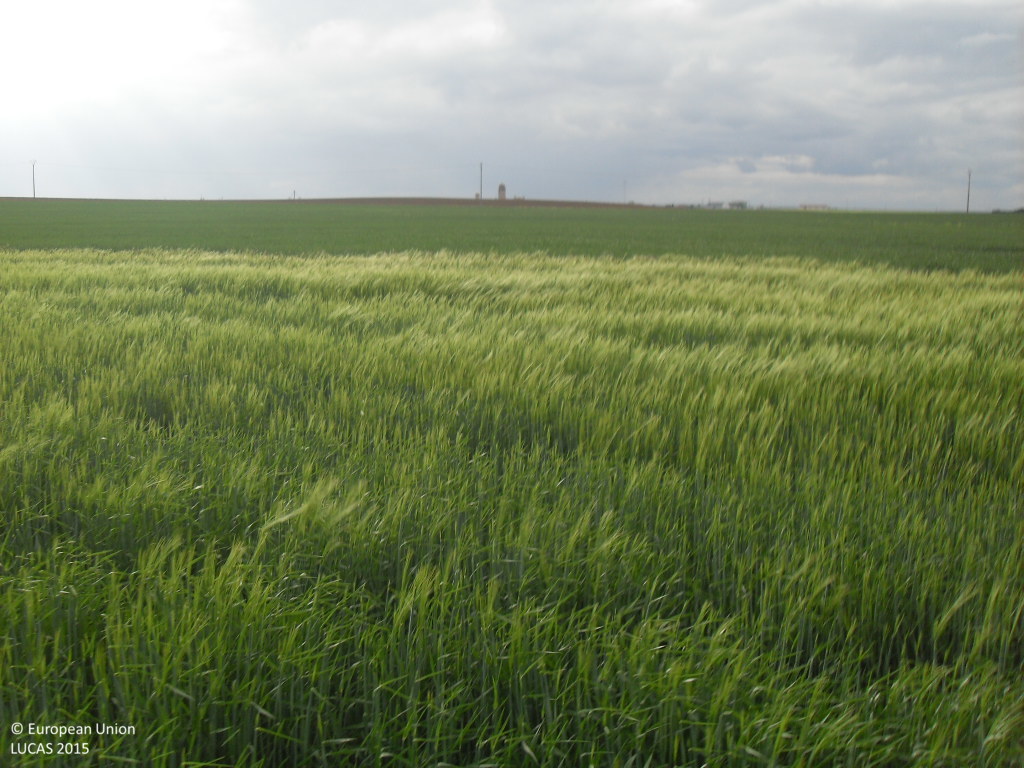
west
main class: Cropland
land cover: Barley
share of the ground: > 75 %
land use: Agriculture (excluding fallow land and kitchen gardens)
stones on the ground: < 10 %
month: April
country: ES
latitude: 41.0067
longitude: -5.1805
